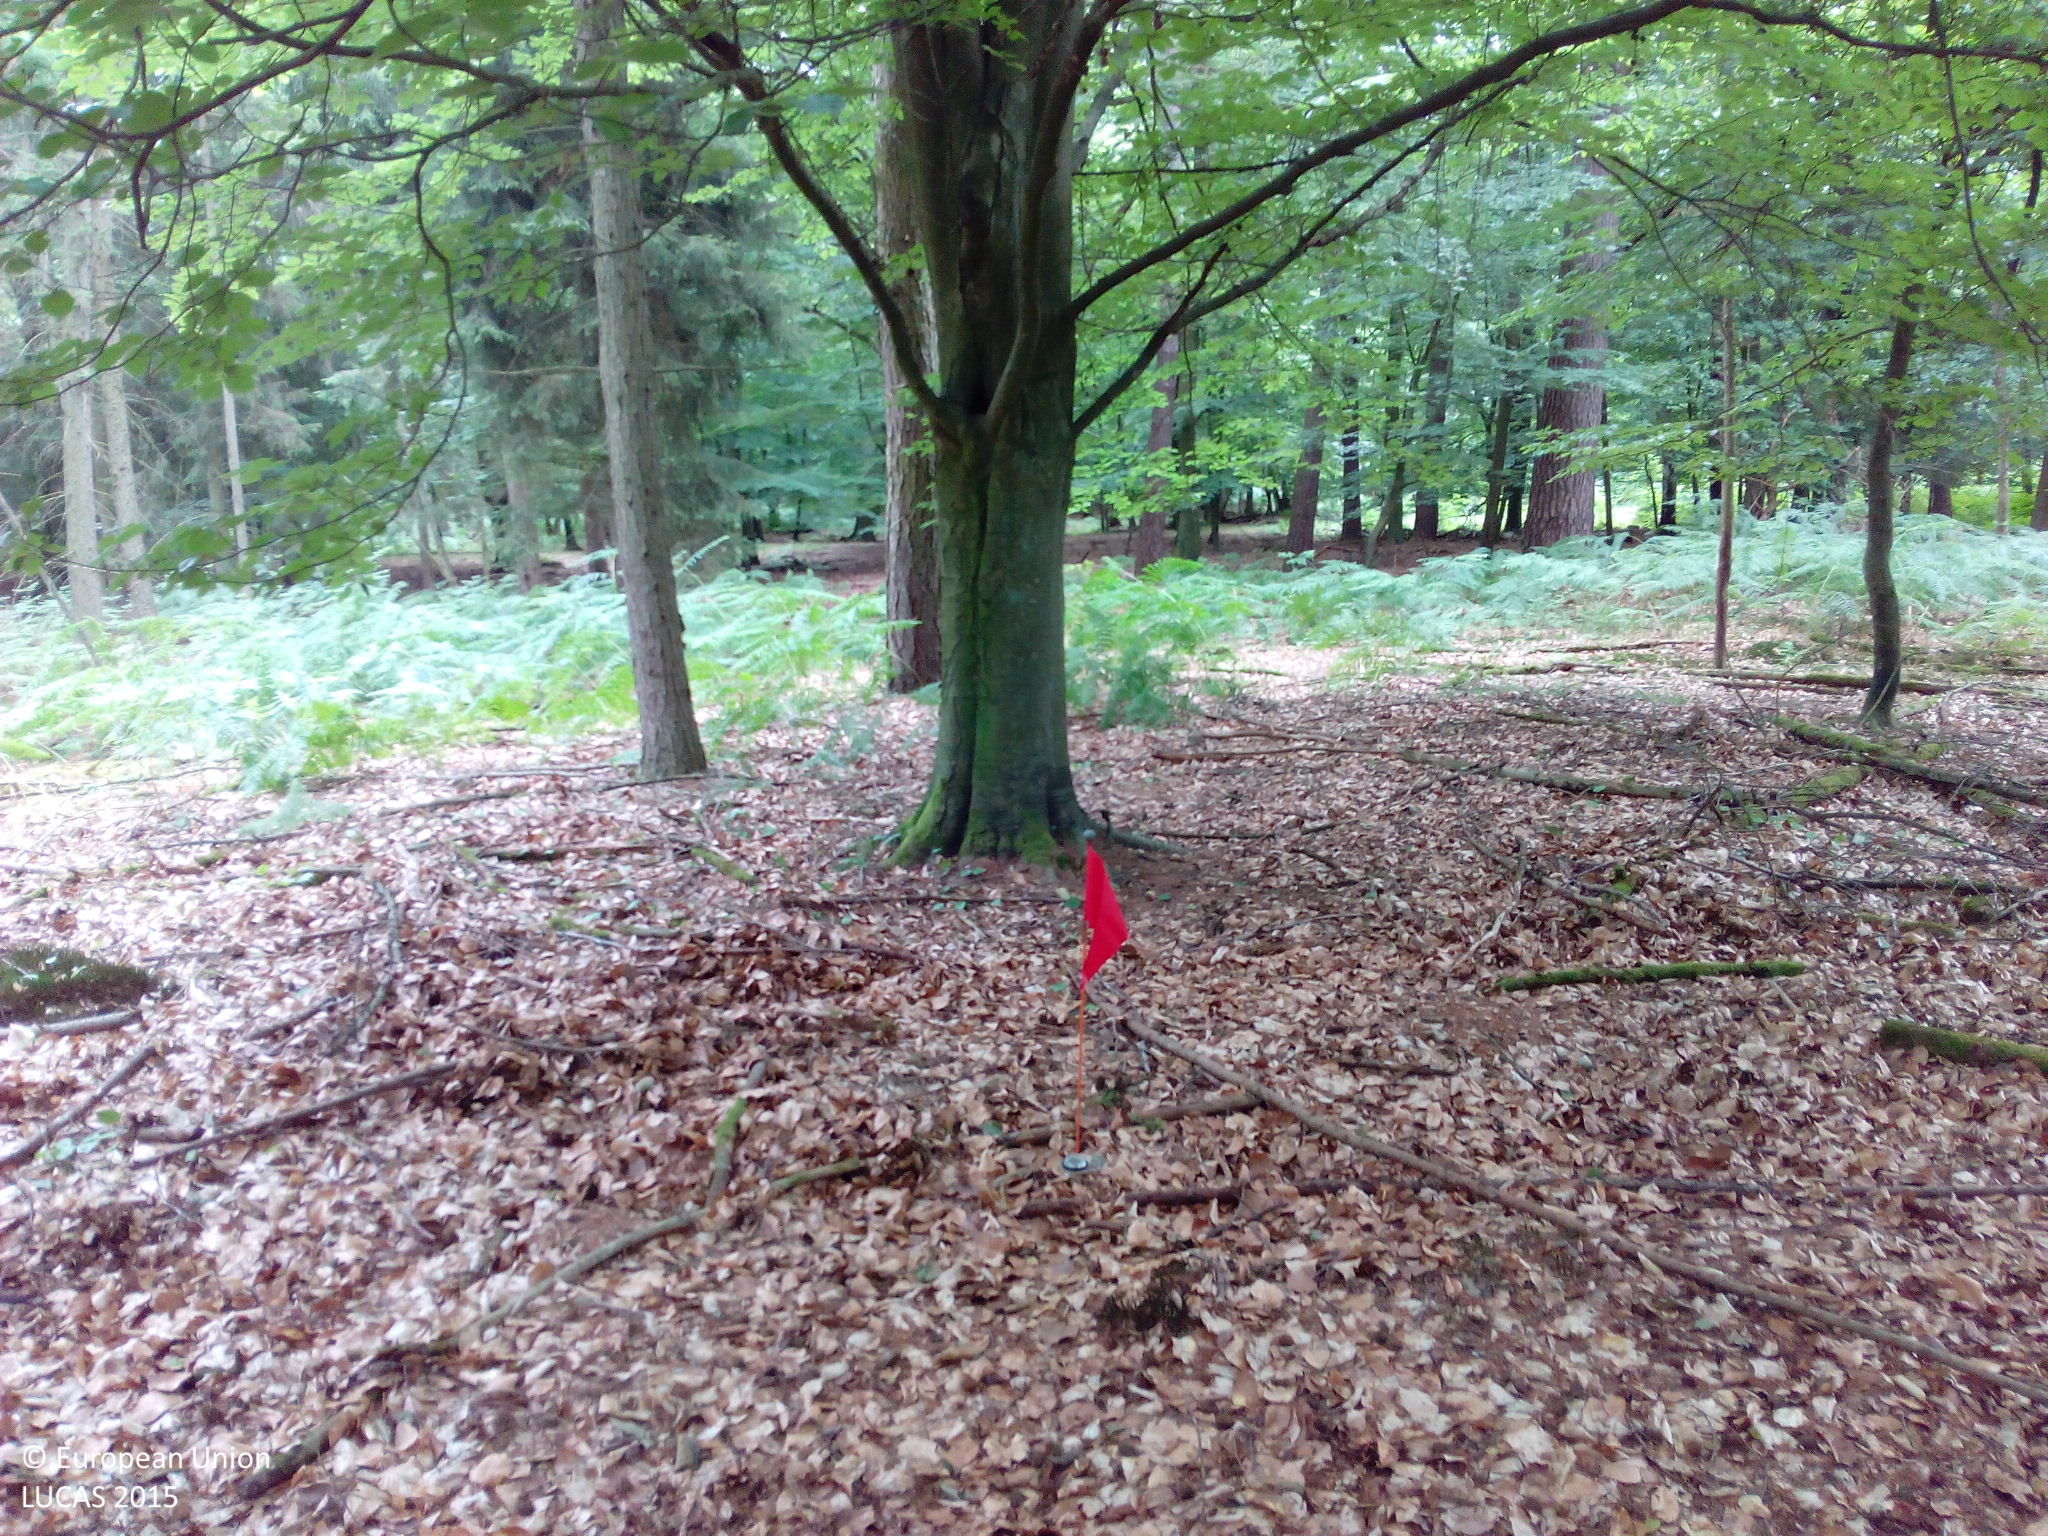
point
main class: Woodland
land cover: Other mixed woodland
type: hemiboreal forest and nemoral coniferous forest and mixed broadleaved-coniferous forest
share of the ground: 50 - 75 %
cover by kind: coniferous forest trees 35 %, broadleaved forest trees 35 %, herbaceous plants 15 %, unconsolidated bare surface 10 %, lichens and mosses 5 %
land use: Forestry
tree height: > 5 m
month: July
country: DE
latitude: 53.5954
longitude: 14.3069
